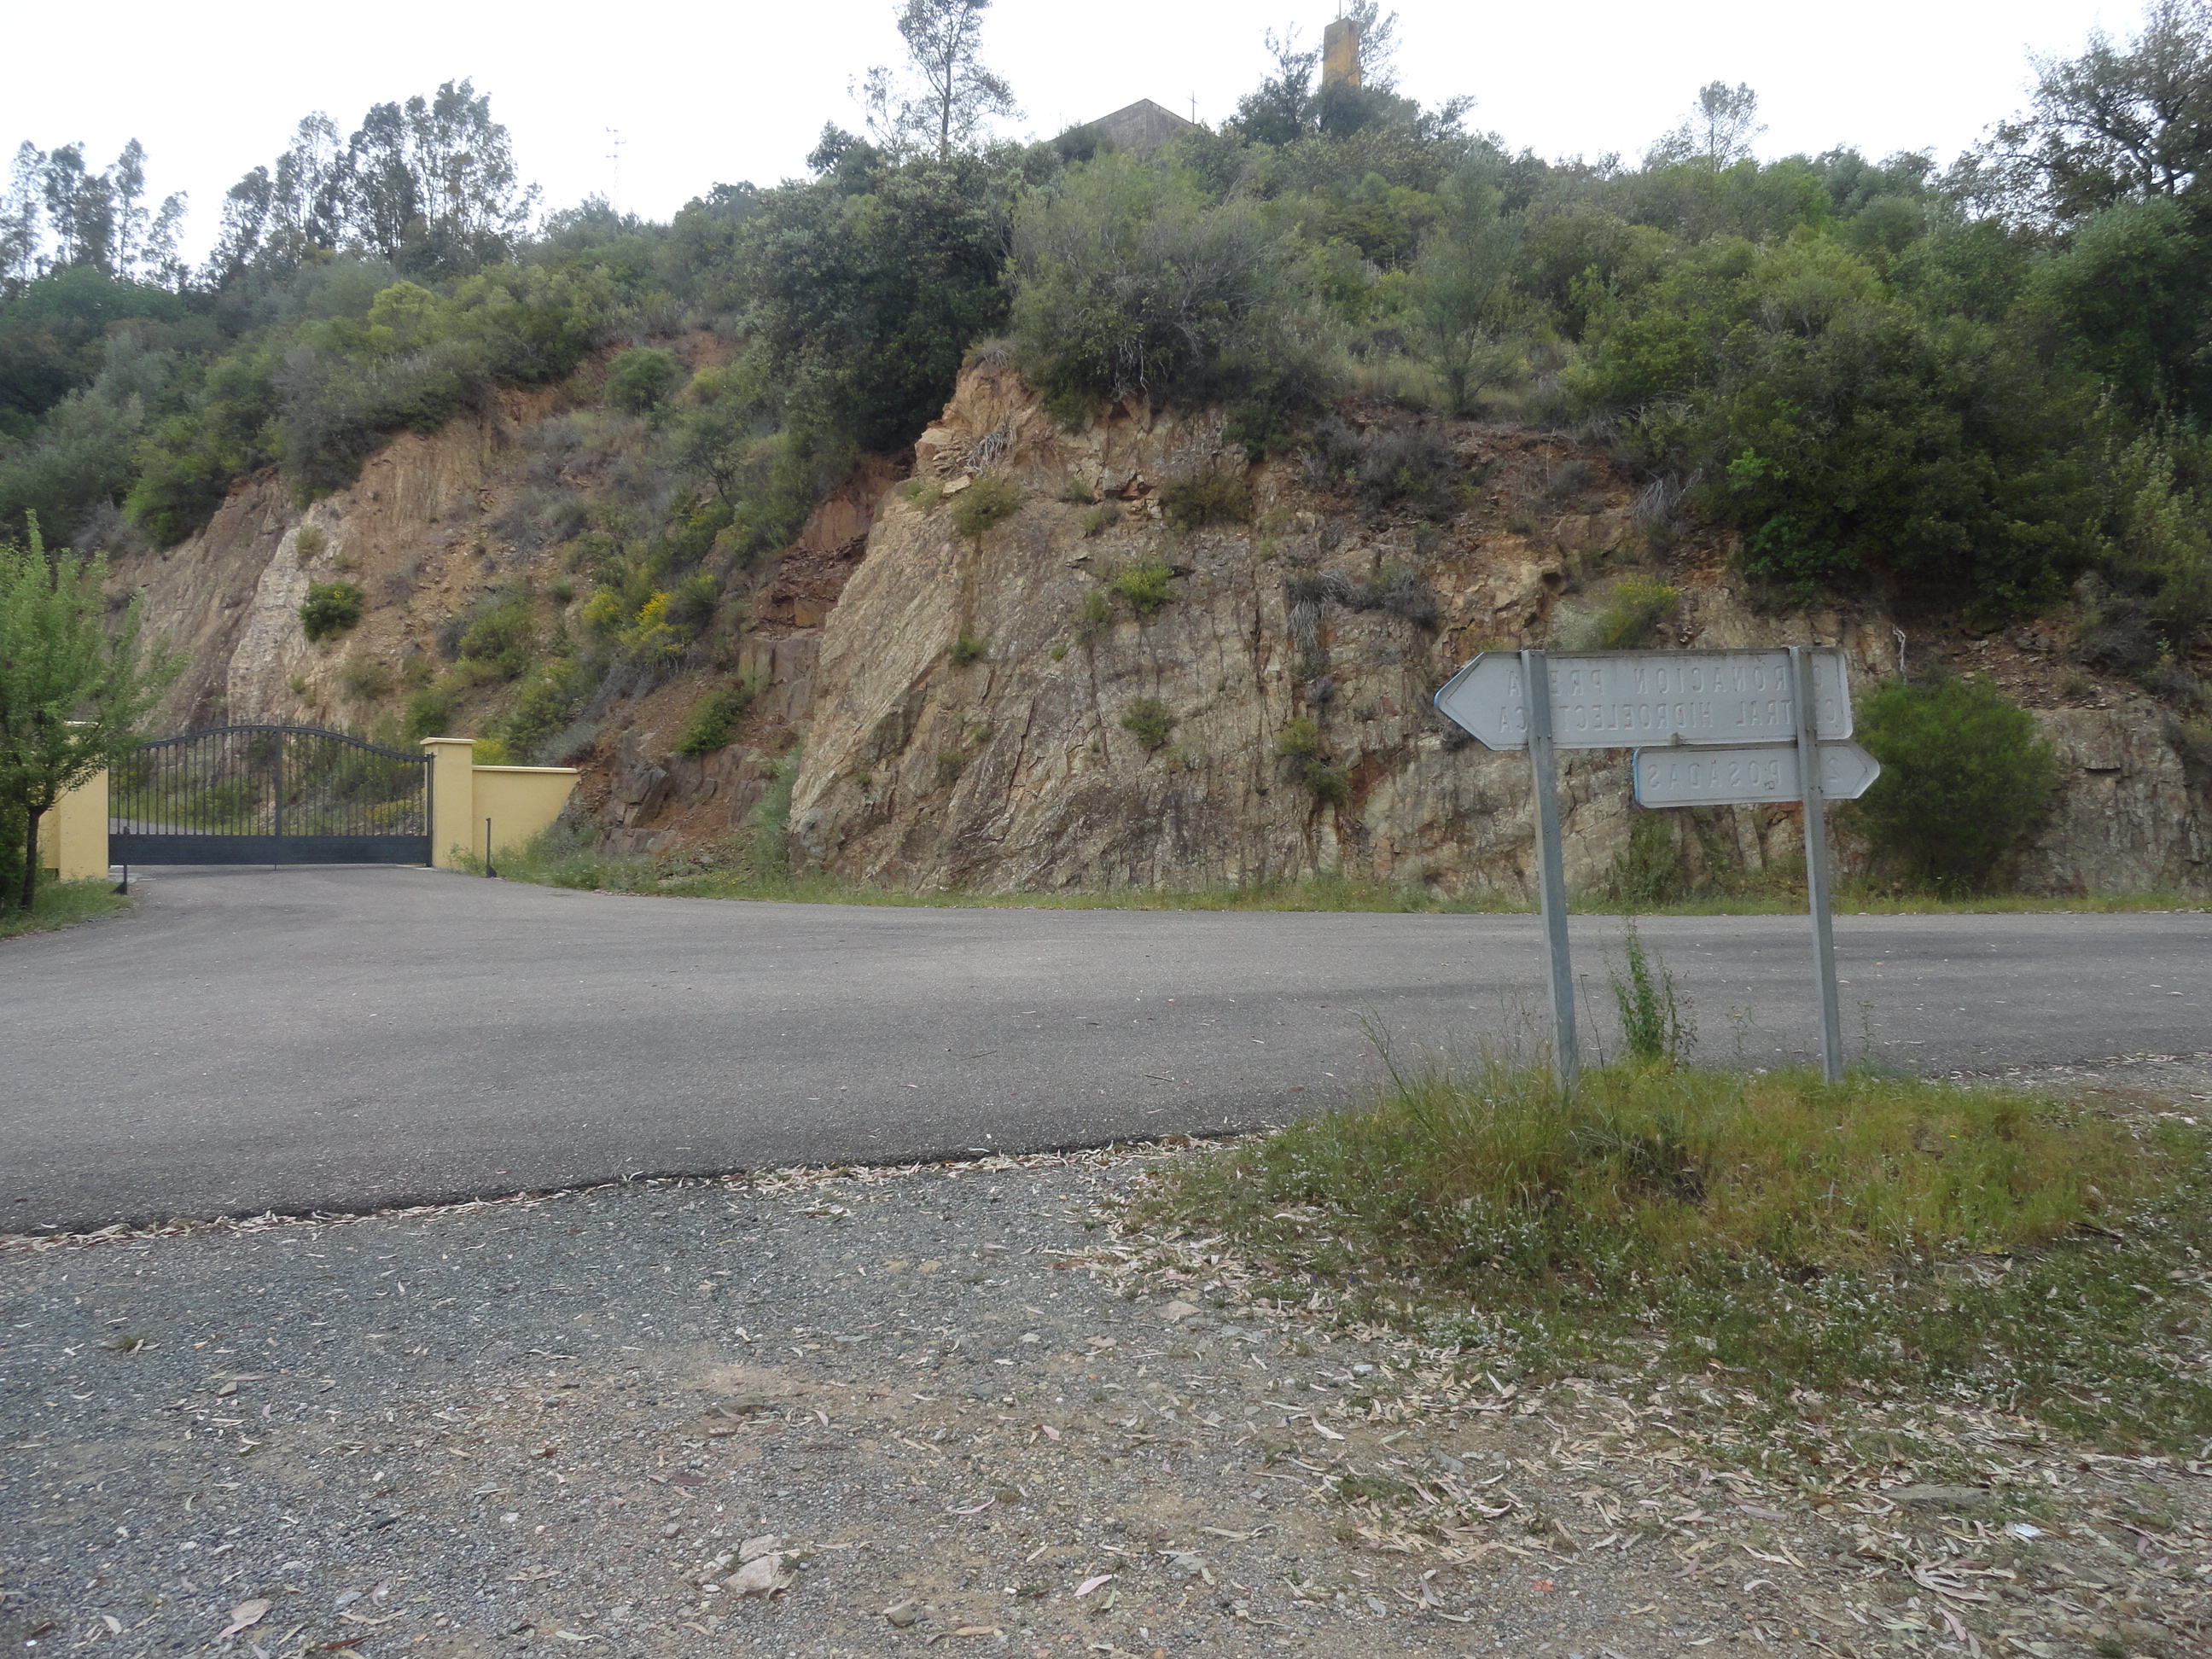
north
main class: Woodland
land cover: Broadleaved woodland
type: broadleaved evergreen forest
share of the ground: > 75 %
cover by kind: broadleaved forest trees 85 %, shrubs 5 %, herbaceous plants 5 %, unconsolidated bare surface 5 %
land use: Semi-natural and natural areas not in use
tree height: > 5 m
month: April
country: ES
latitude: 37.8981
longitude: -5.2025
